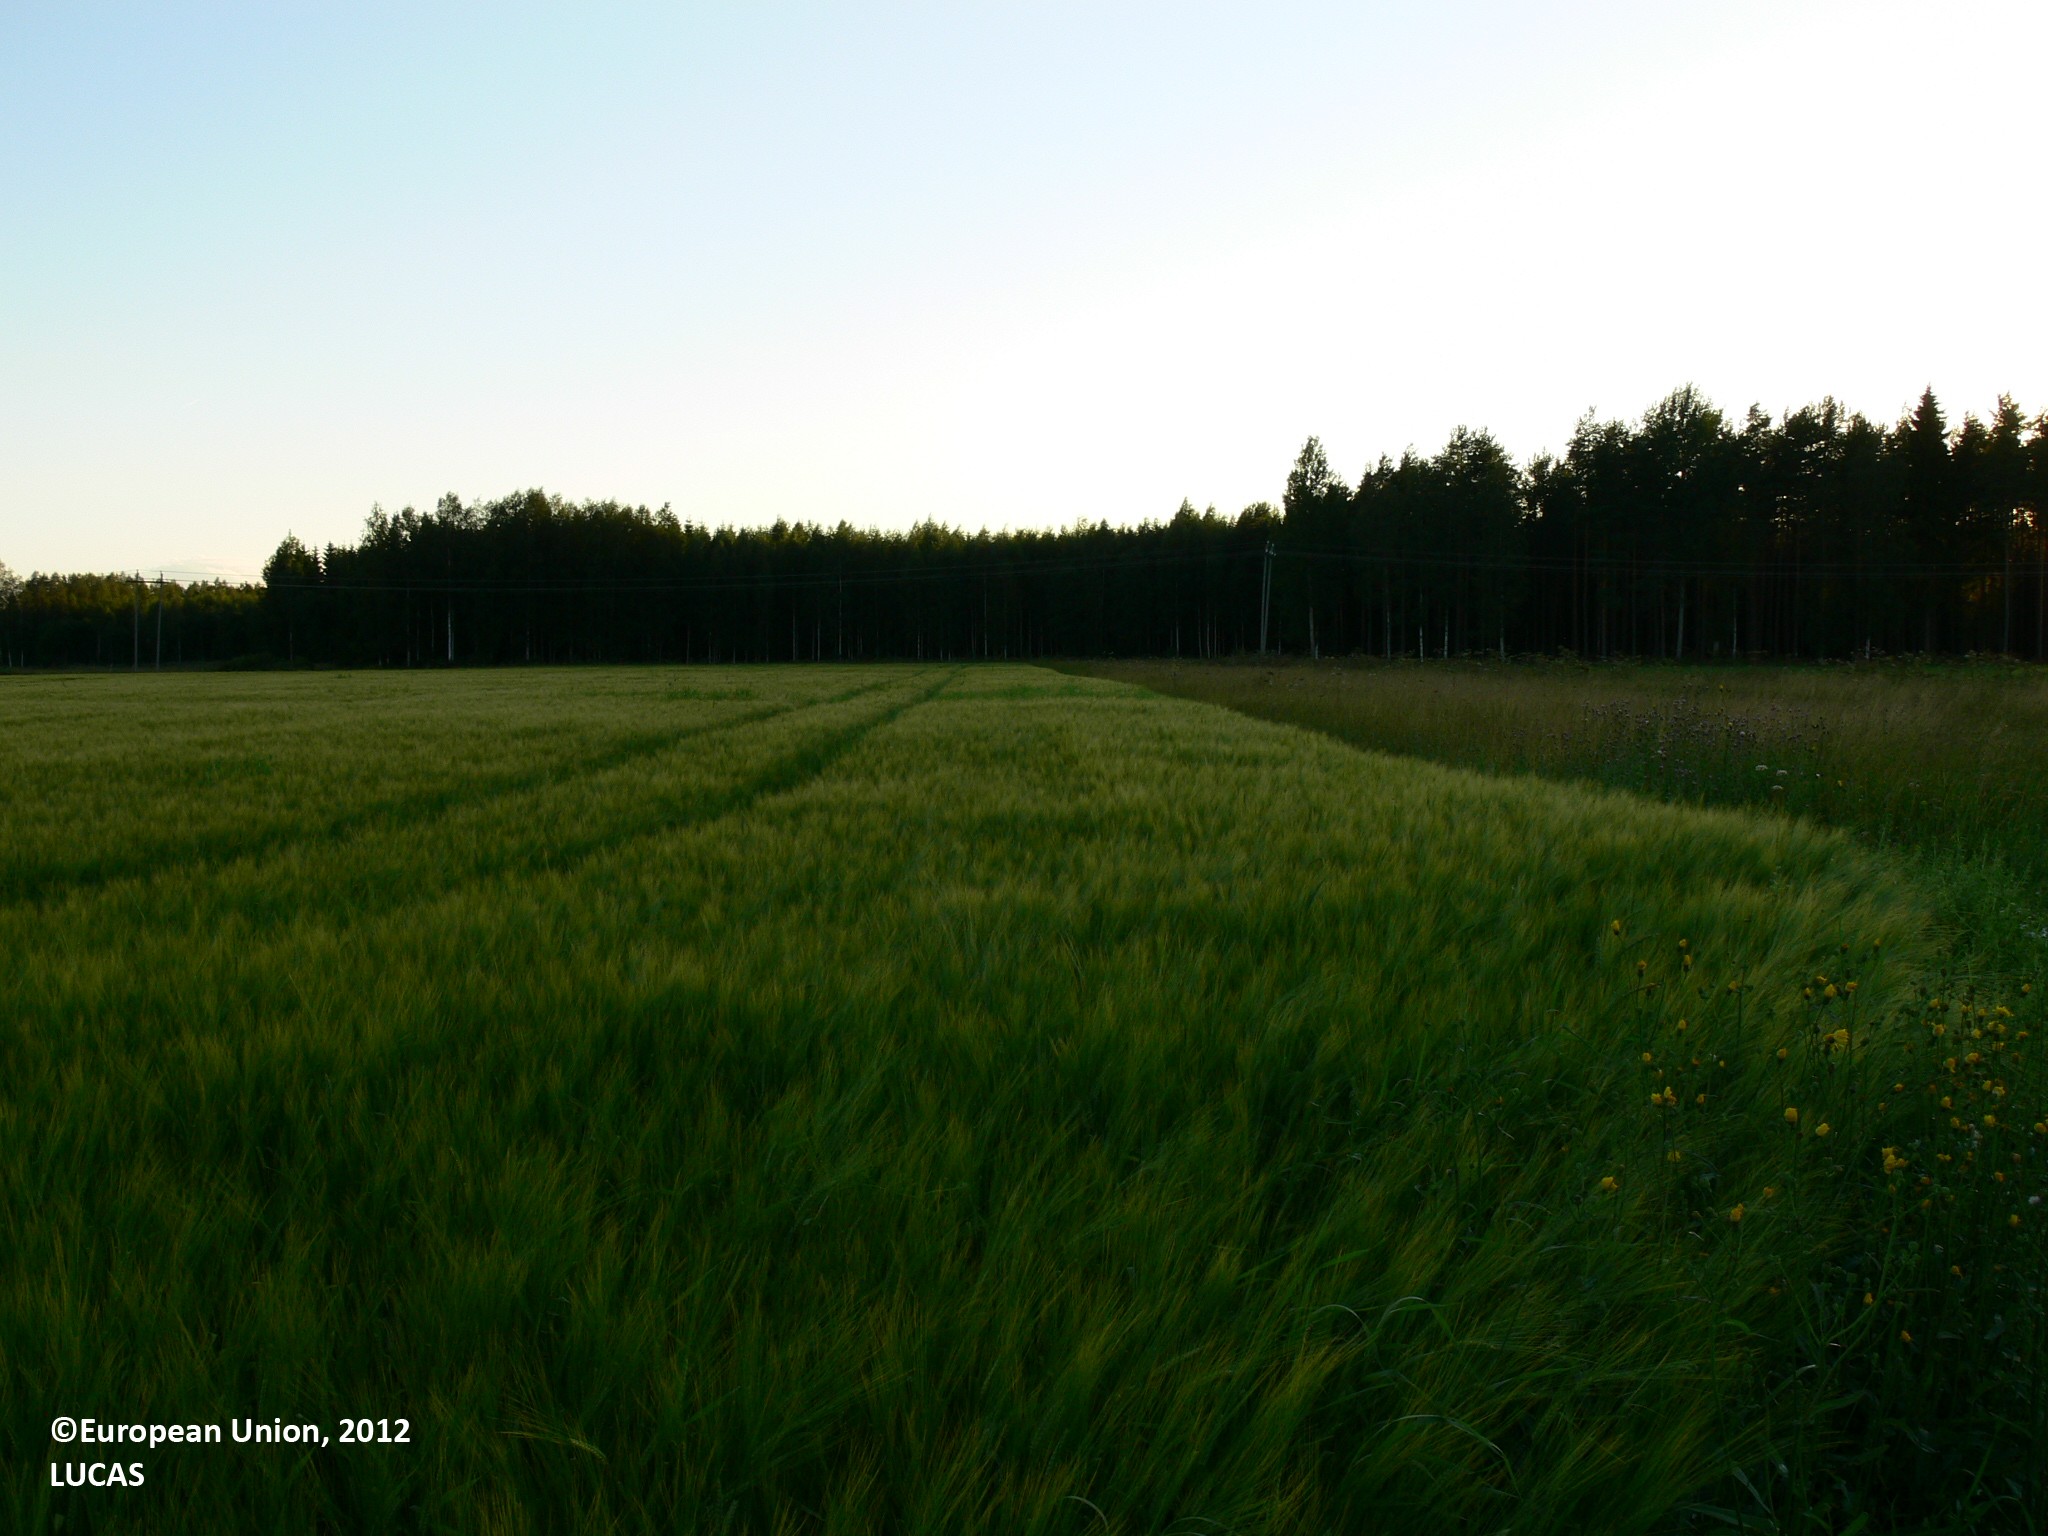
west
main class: Cropland
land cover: Barley
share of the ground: > 75 %
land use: Agriculture (excluding fallow land and kitchen gardens)
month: August
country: FI
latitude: 61.9091
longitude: 29.2544
